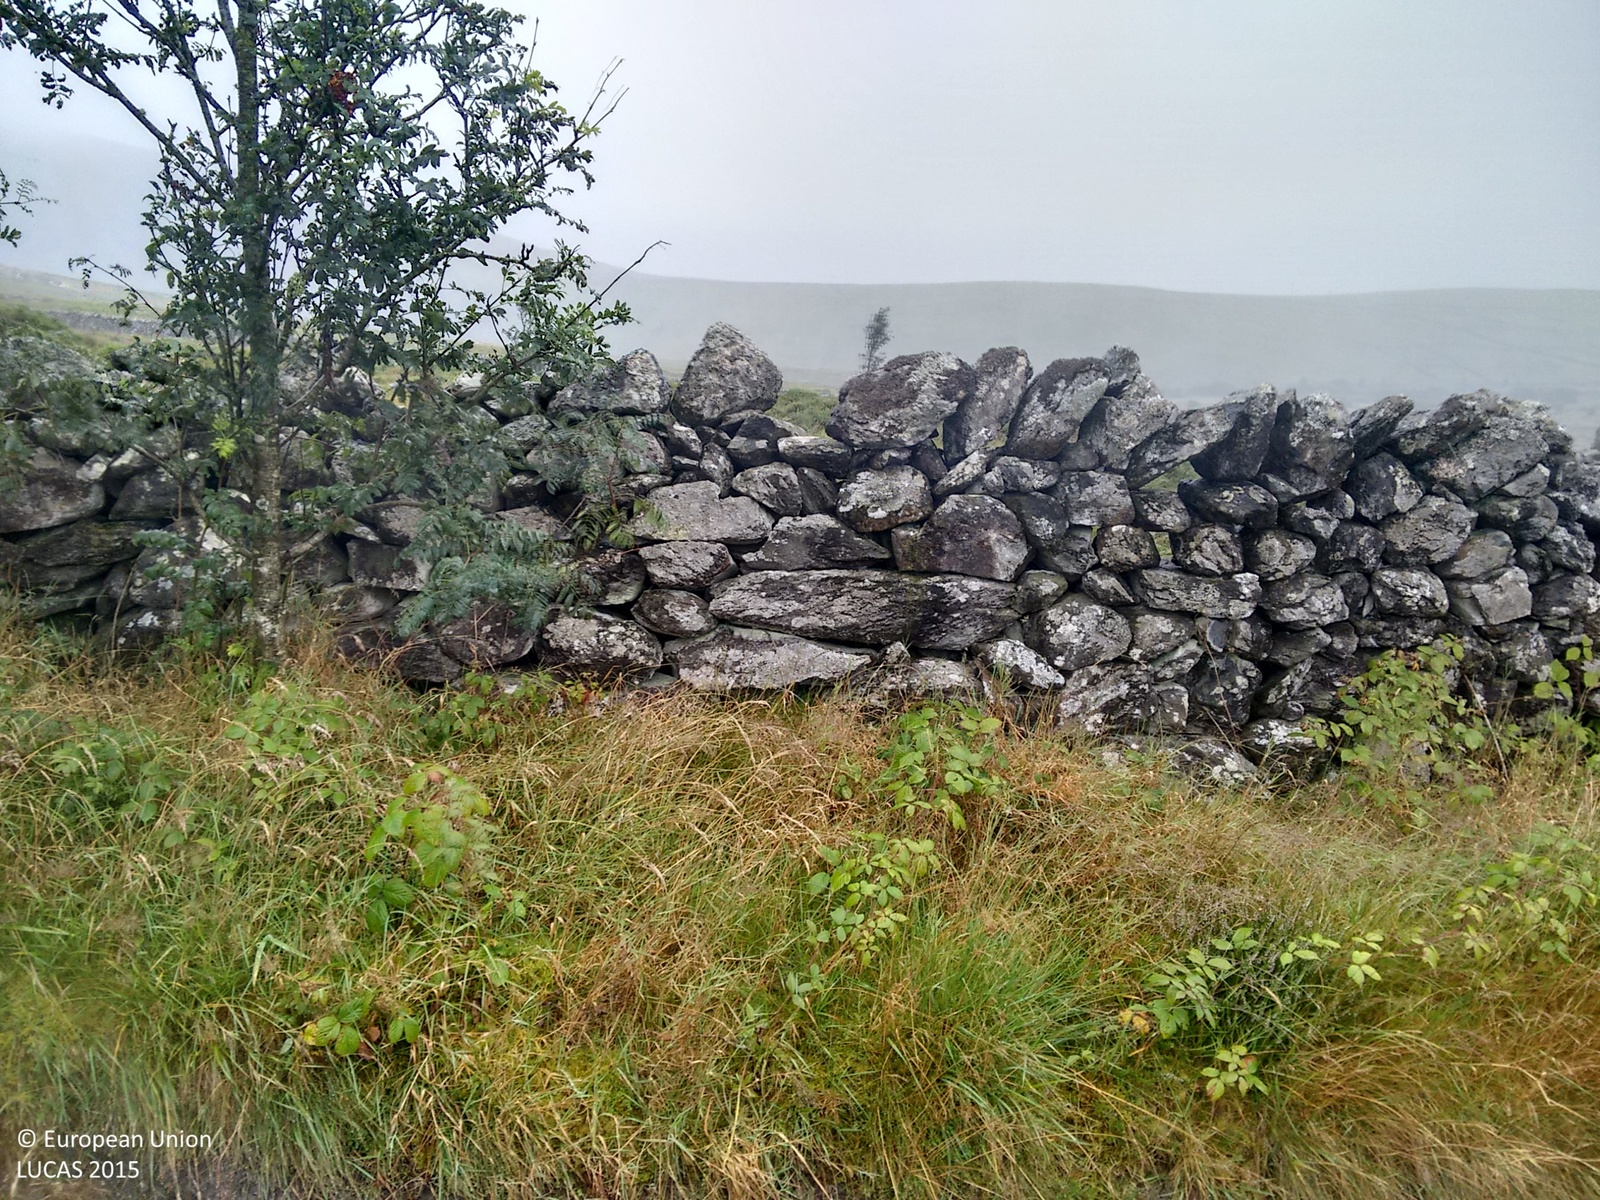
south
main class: Grassland
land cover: Grassland without tree/shrub cover
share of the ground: > 75 %
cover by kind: herbaceous plants 100 %
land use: Agriculture (excluding fallow land and kitchen gardens)
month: August
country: GB
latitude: 53.0284
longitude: -4.2495
